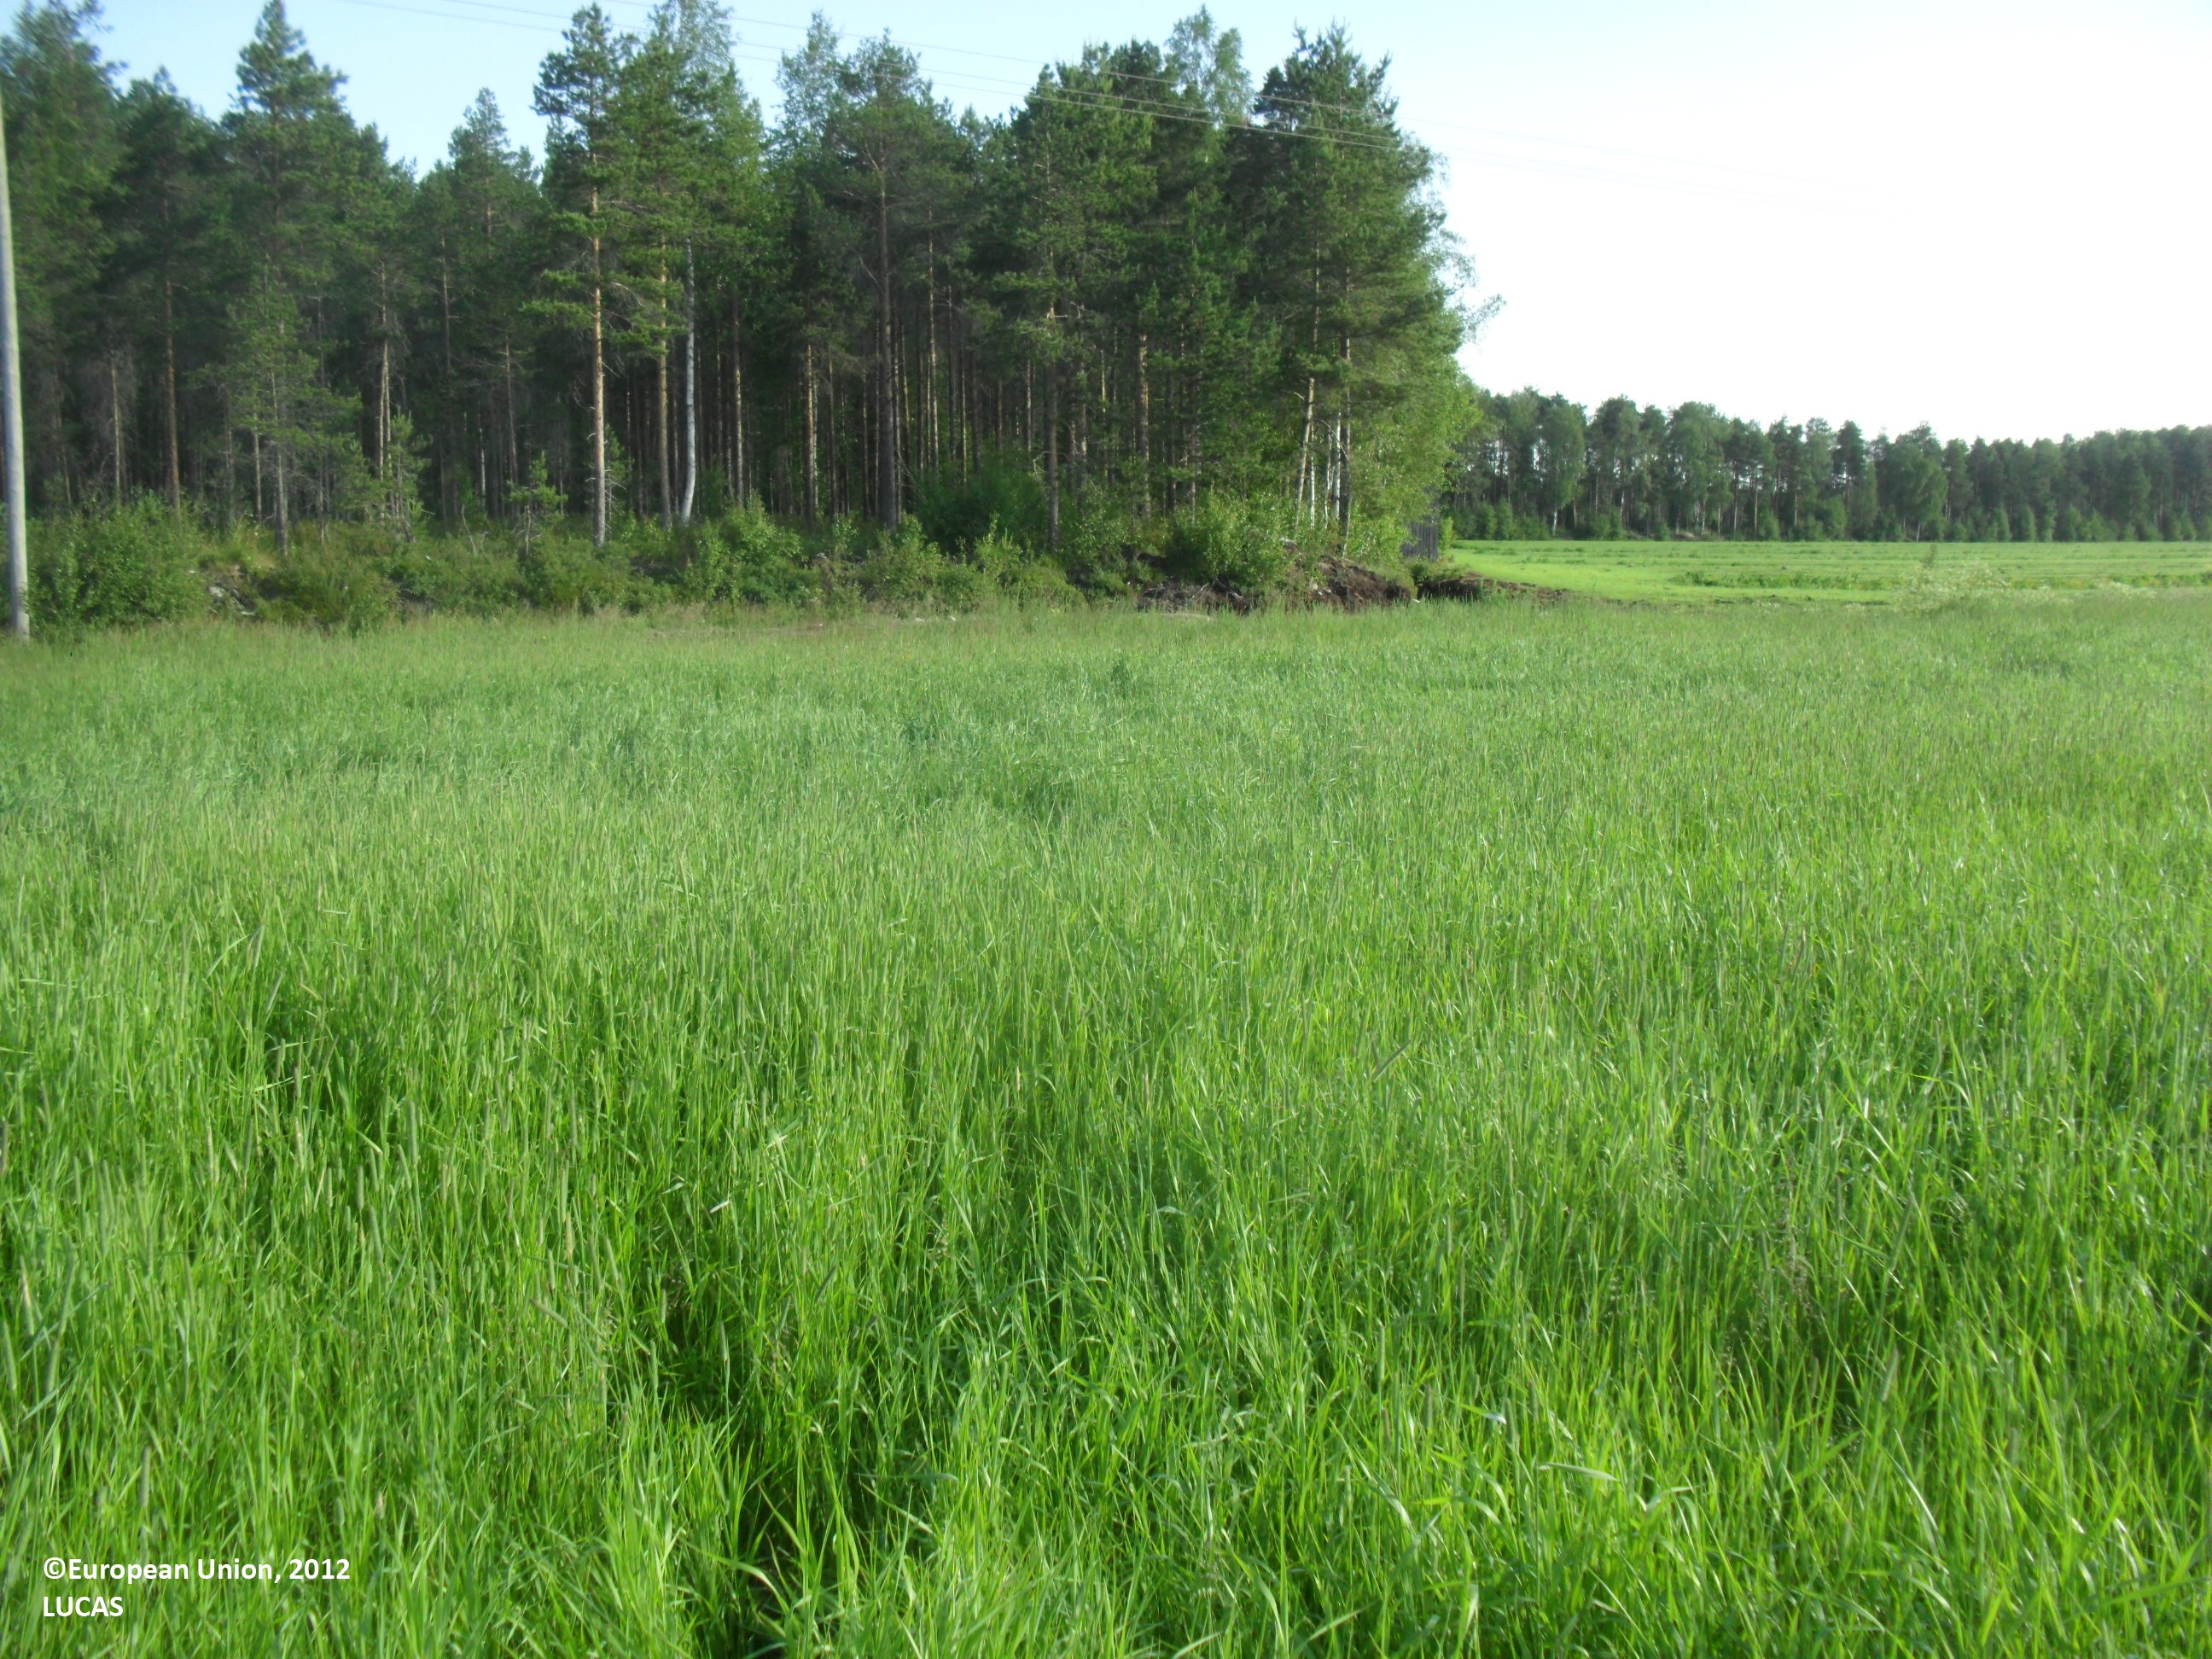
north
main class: Cropland
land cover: Temporary grasslands
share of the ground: > 75 %
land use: Agriculture (excluding fallow land and kitchen gardens)
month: July
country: FI
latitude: 63.5585
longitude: 23.7329
